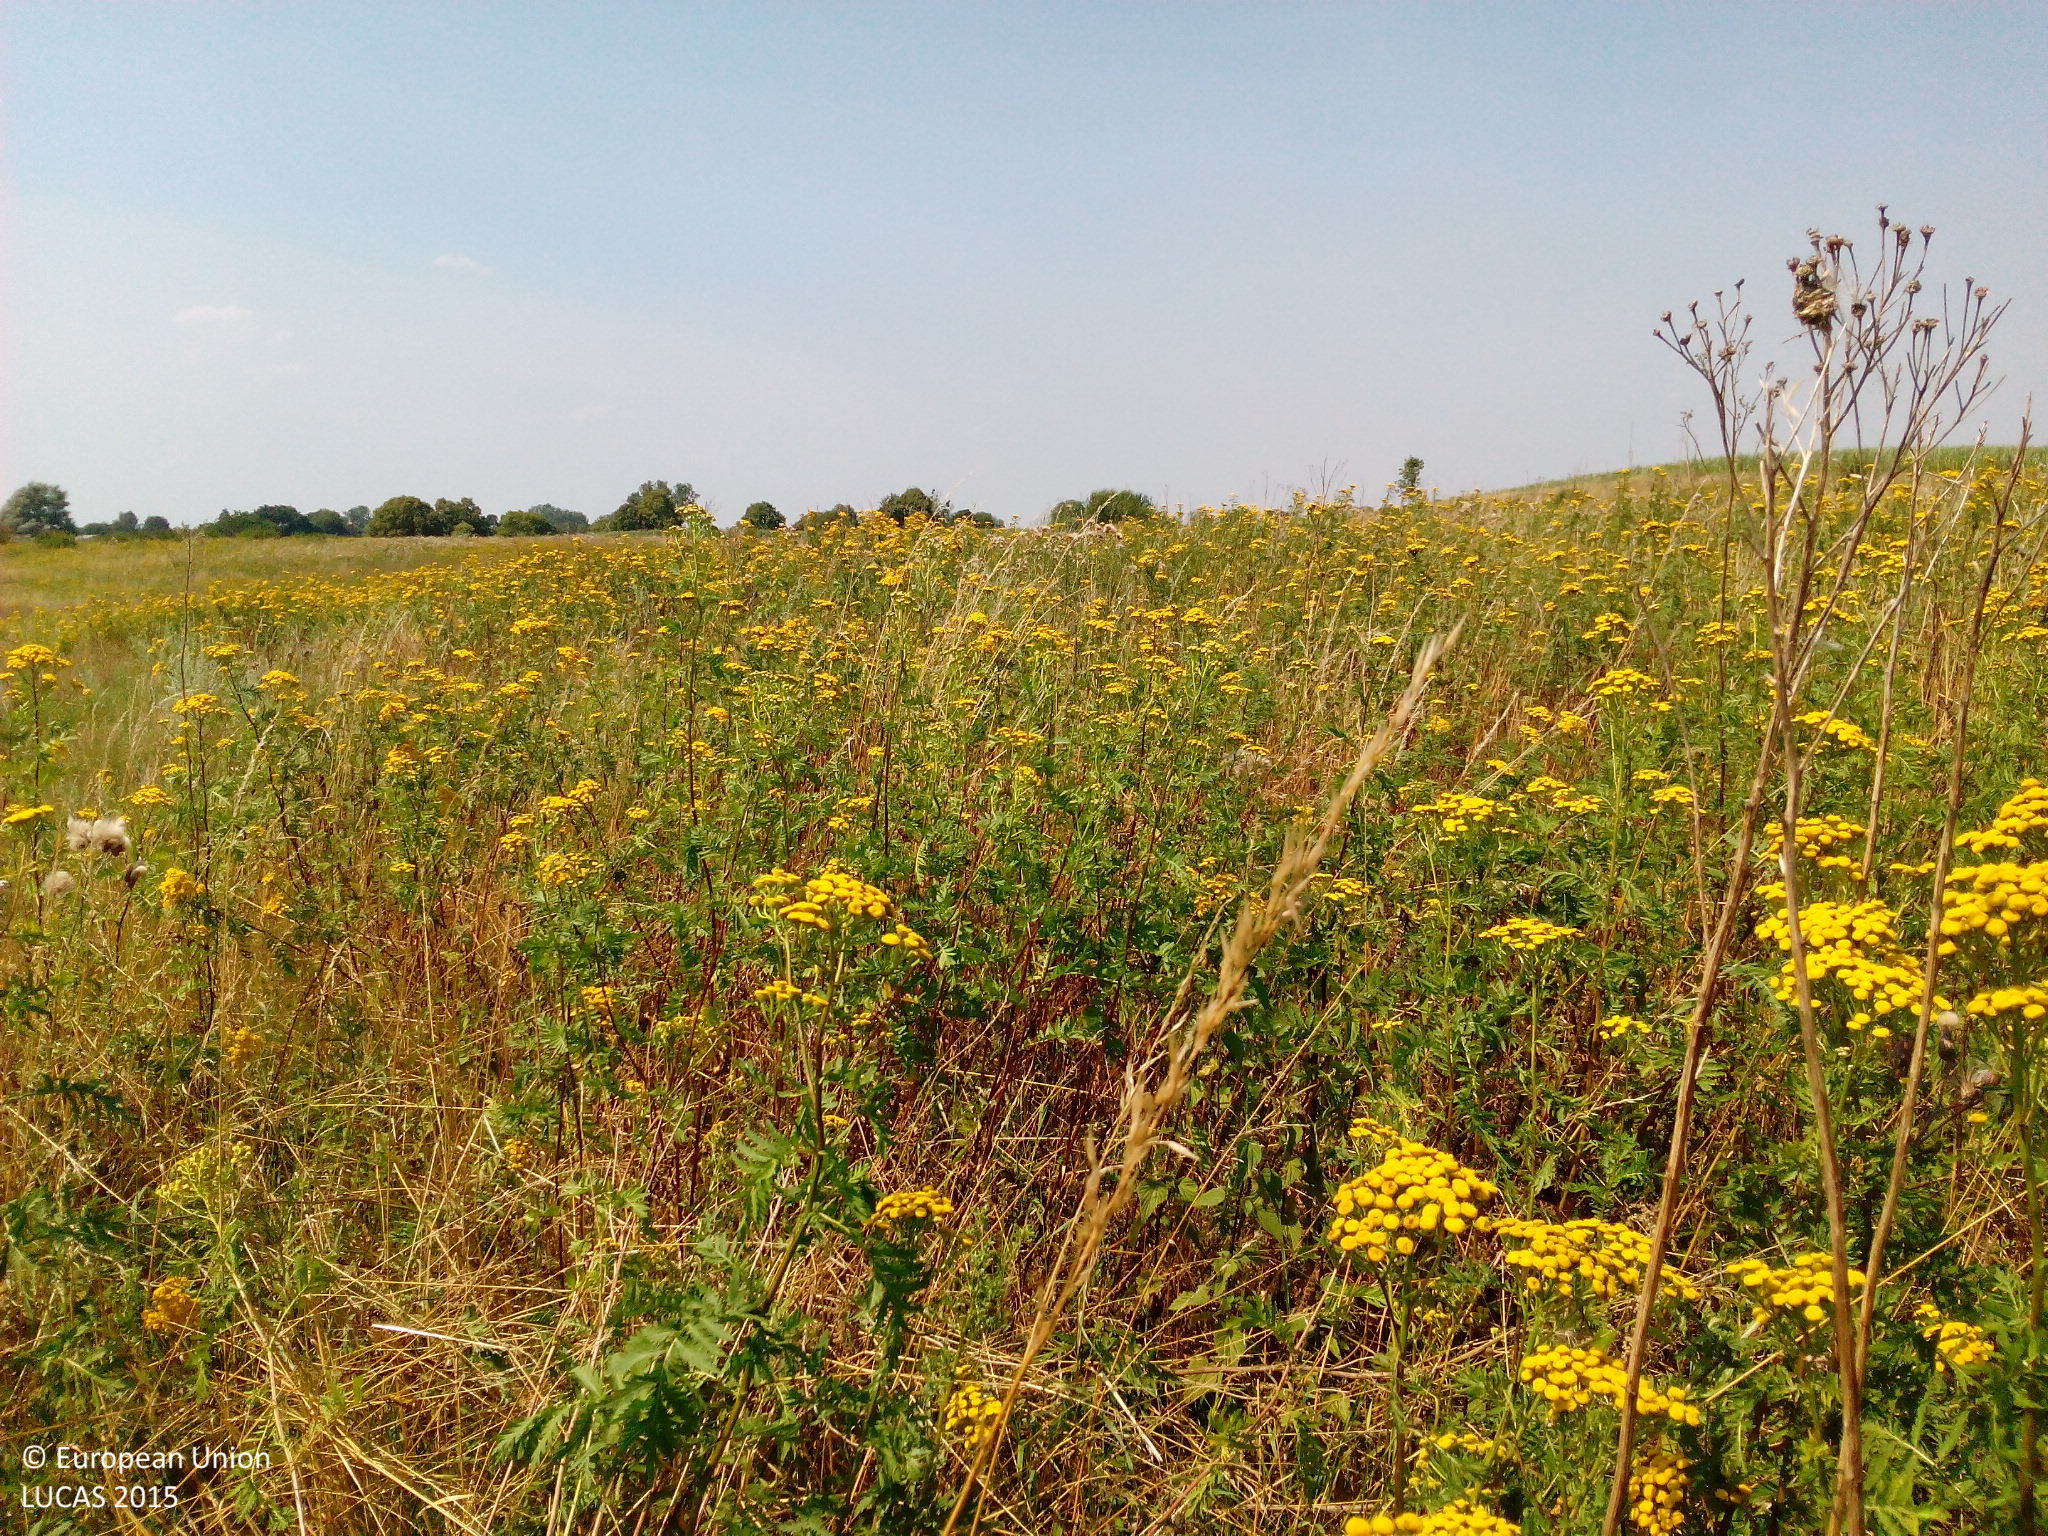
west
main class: Grassland
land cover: Spontaneously vegetated surfaces
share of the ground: > 75 %
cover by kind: herbaceous plants 100 %
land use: Fallow land
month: August
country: DE
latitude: 53.3308
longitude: 13.5887
